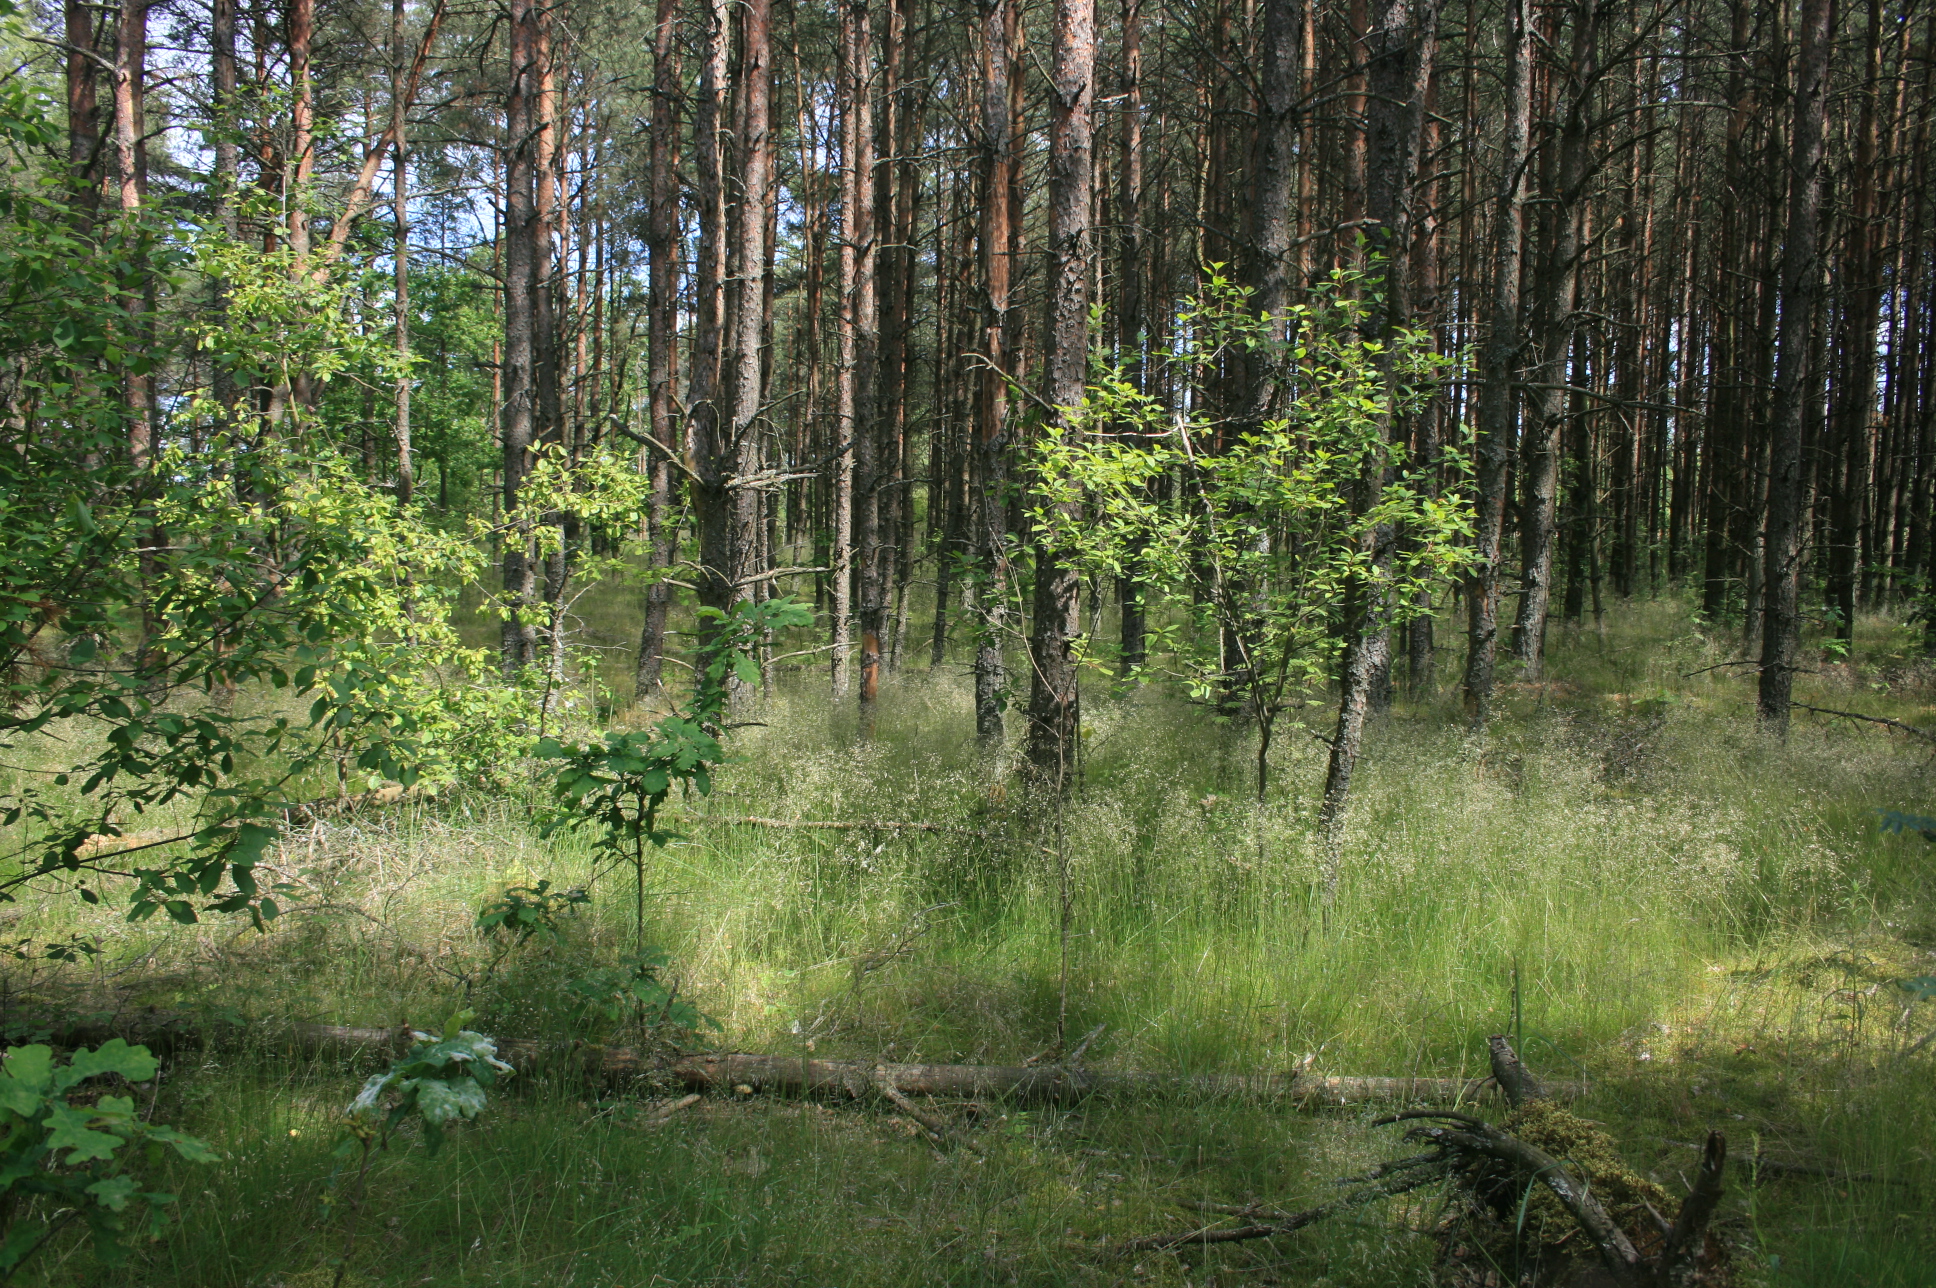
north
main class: Woodland
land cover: Pine dominated mixed woodland
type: hemiboreal forest and nemoral coniferous forest and mixed broadleaved-coniferous forest
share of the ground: > 75 %
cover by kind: coniferous forest trees 55 %, broadleaved forest trees 30 %, herbaceous plants 15 %
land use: Forestry
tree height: > 5 m
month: June
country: LT
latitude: 55.2114
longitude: 21.7267
